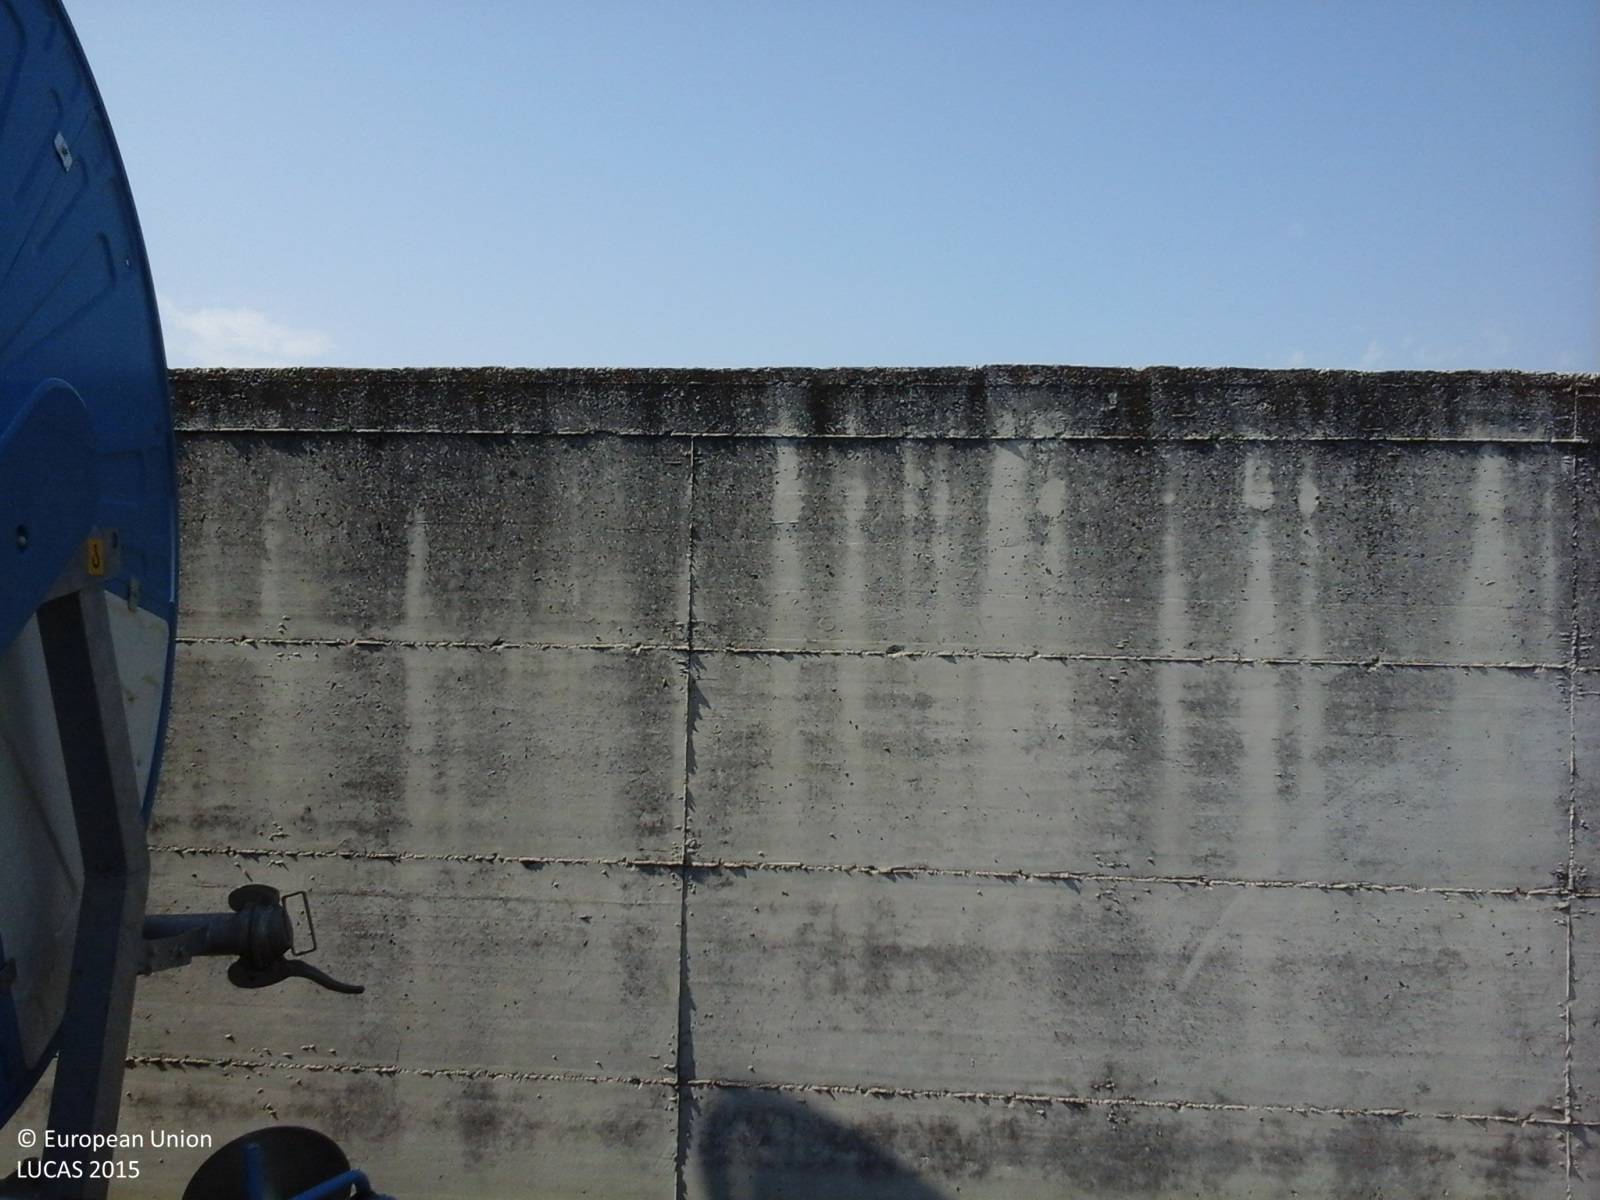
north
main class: Cropland
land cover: Maize
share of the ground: > 75 %
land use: Agriculture (excluding fallow land and kitchen gardens)
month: July
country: IT
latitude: 41.0125
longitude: 14.1567
